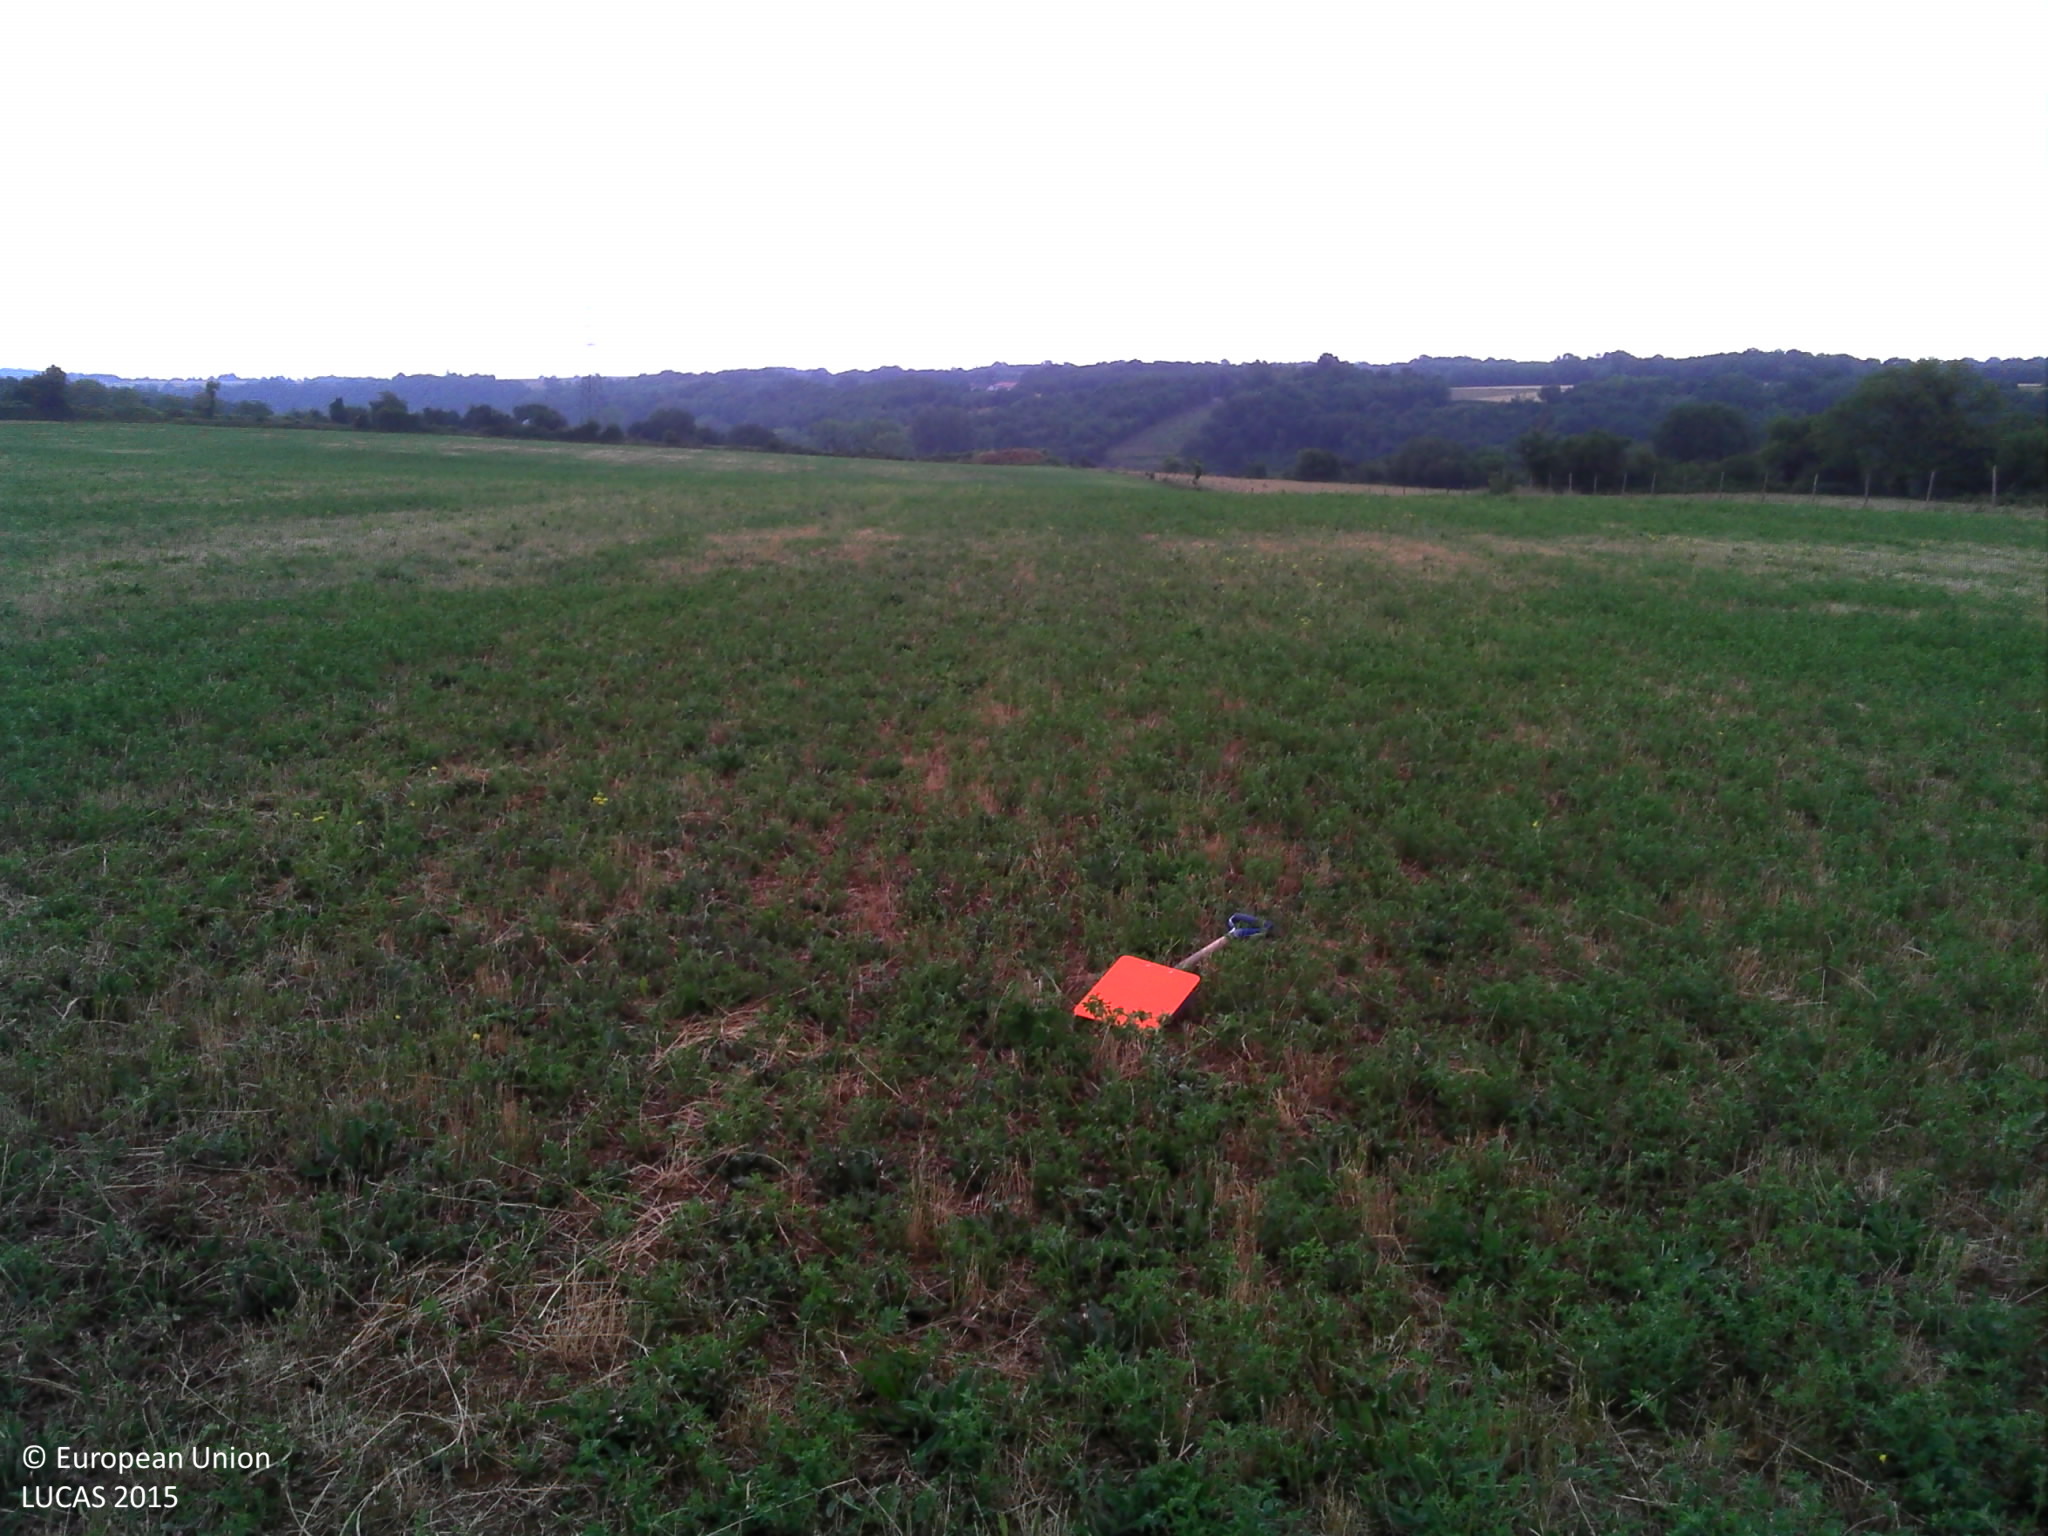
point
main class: Cropland
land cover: Lucerne
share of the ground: > 75 %
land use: Agriculture (excluding fallow land and kitchen gardens)
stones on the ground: < 10 %
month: June
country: FR
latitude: 45.9809
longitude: 0.2892
